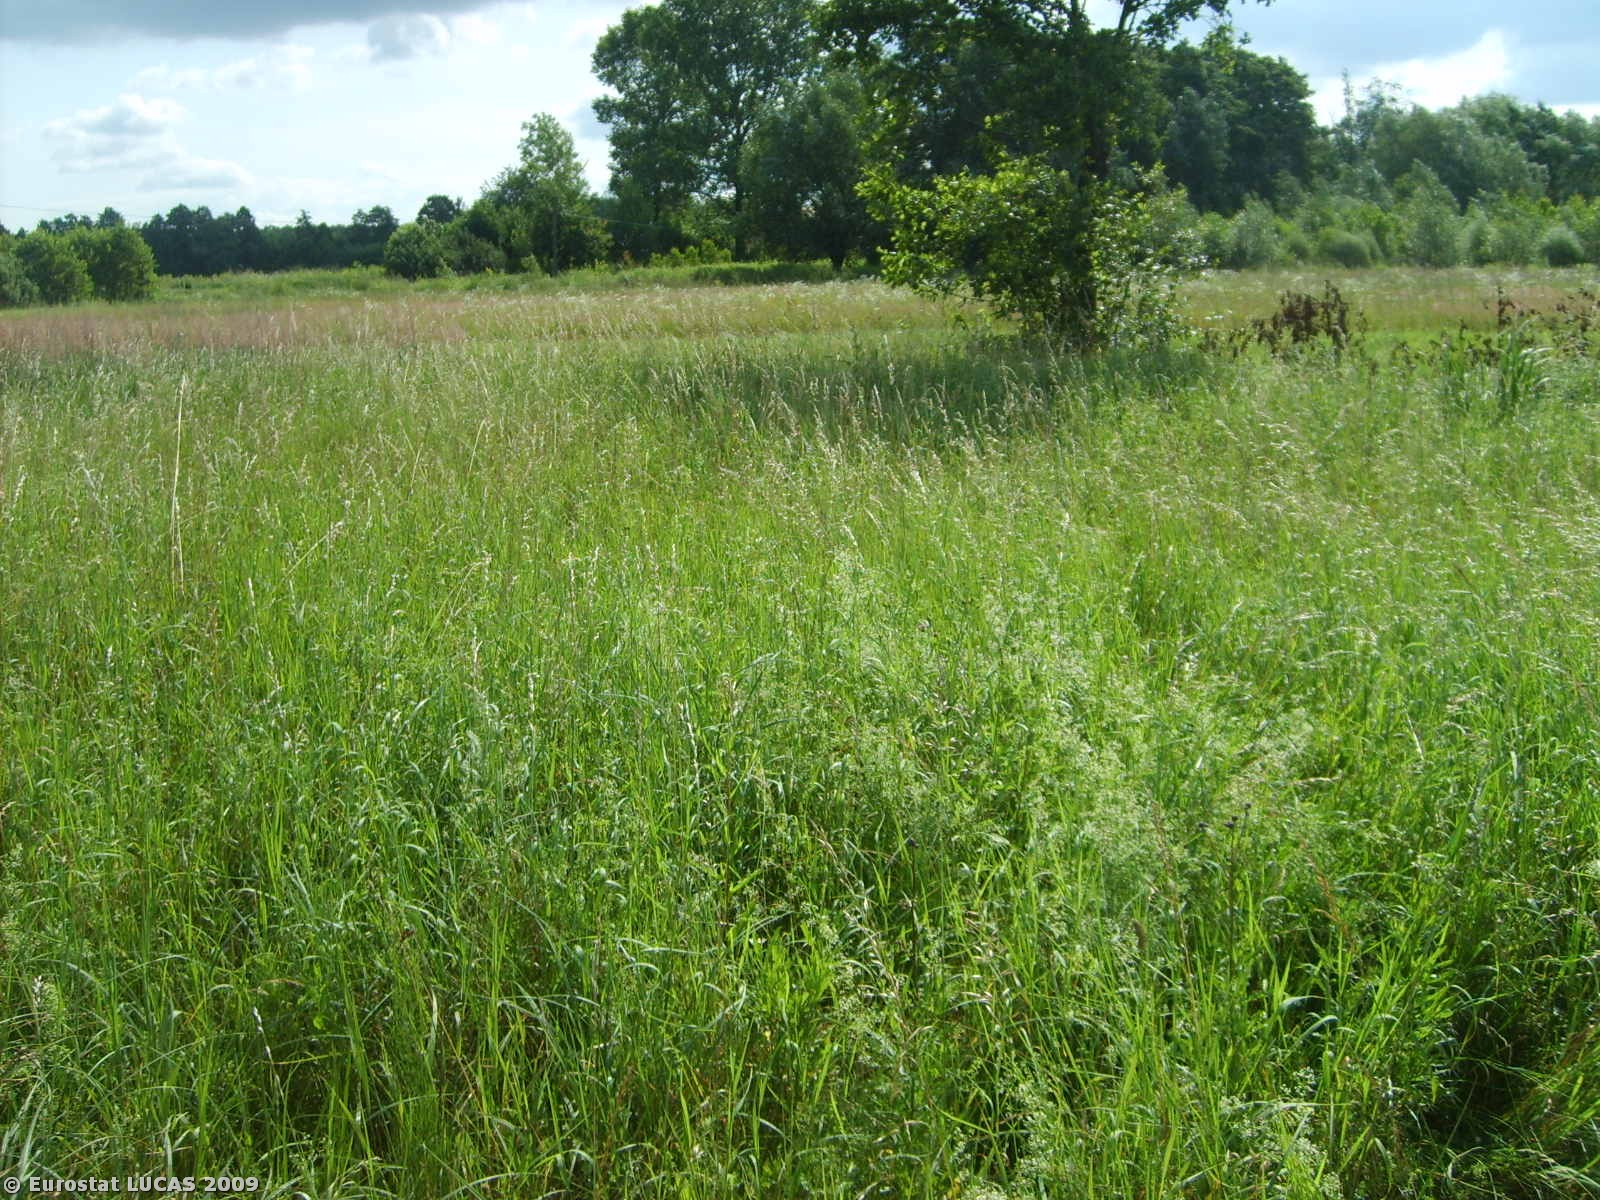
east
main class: Grassland
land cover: Grassland with sparse tree/shrub cover
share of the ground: > 75 %
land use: Unused
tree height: < 5 m
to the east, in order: Grassland with sparse tree/shrub cover; Grassland without tree/shrub cover; Tracks; Ditches and canals; Grassland with sparse tree/shrub cover; Electric lines; Grassland with sparse tree/shrub cover; Shrubland with sparse tree cover; Grass margins; Paved roads, cycling and walking lanes; Grass margins; Shrubland with sparse tree cover; Fences; Artificial constructions in urban areas; Fences; Electric lines; Barley
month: July
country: PL
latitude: 50.3070
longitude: 21.1523
